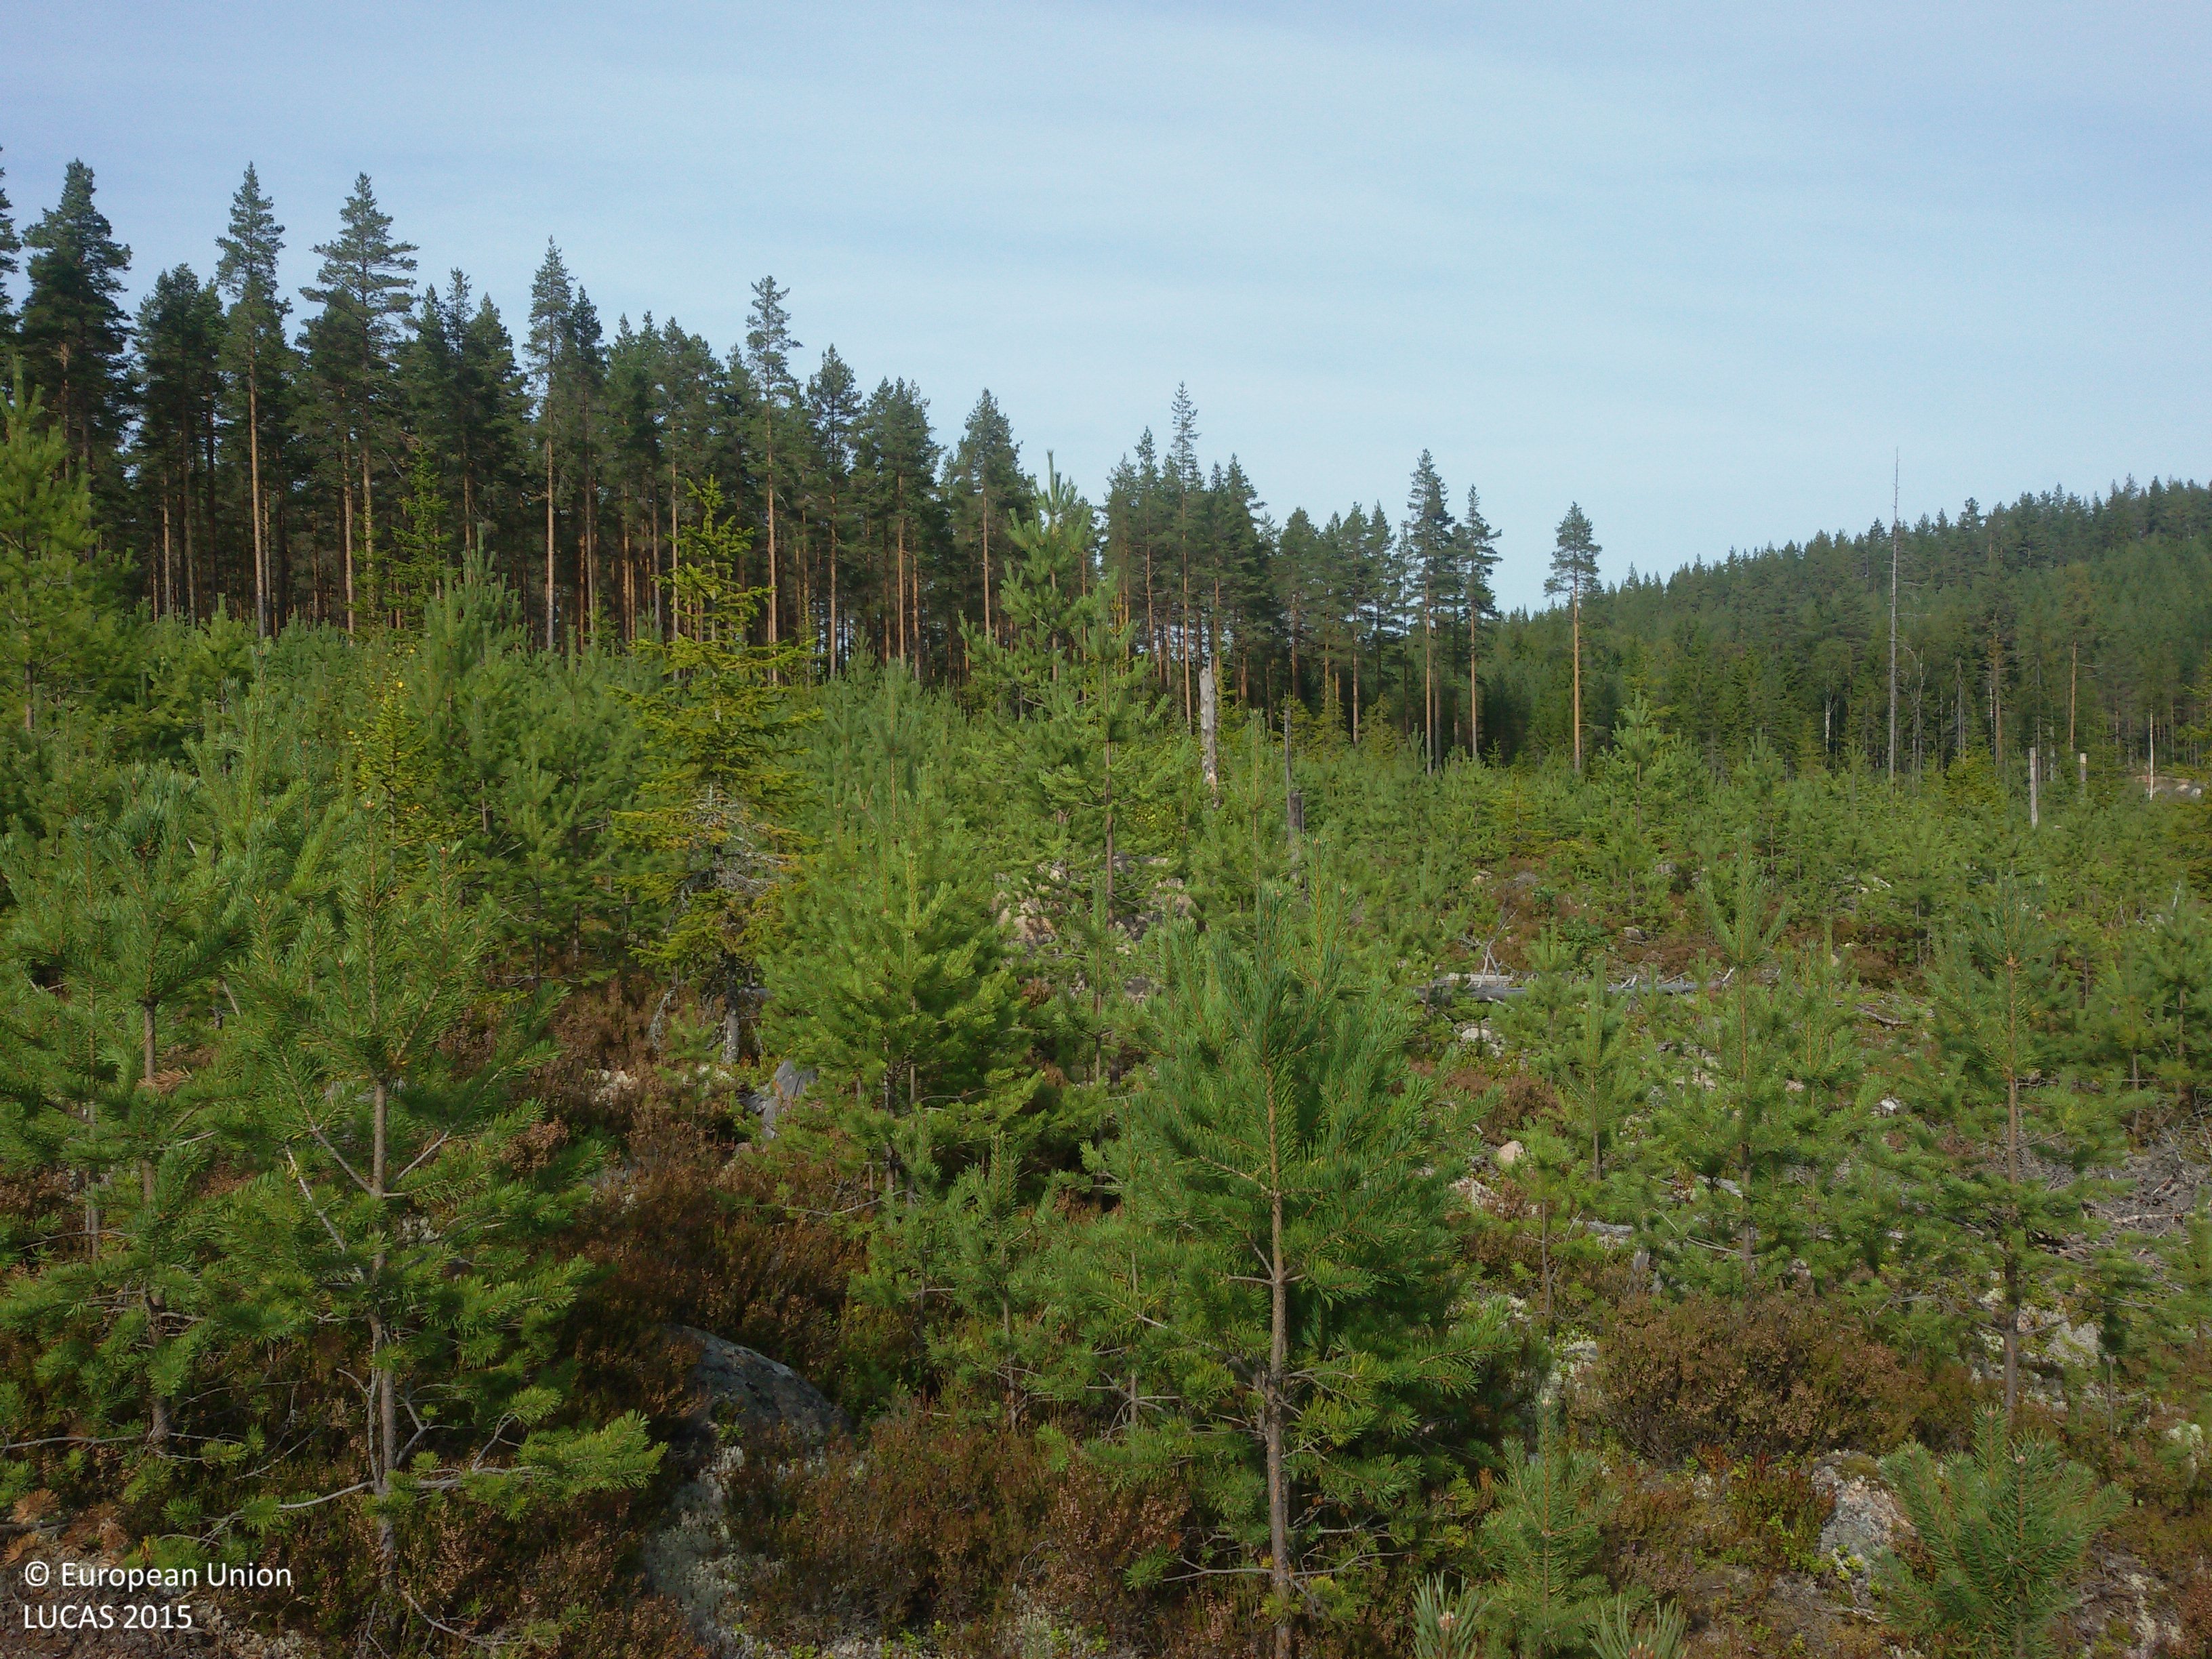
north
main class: Woodland
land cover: Pine dominated coniferous woodland
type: boreal forest
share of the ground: 50 - 75 %
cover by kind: coniferous forest trees 70 %, lichens and mosses 15 %, shrubs 10 %, herbaceous plants 5 %
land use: Forestry
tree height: < 5 m
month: September
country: SE
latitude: 61.0185
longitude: 15.3328
